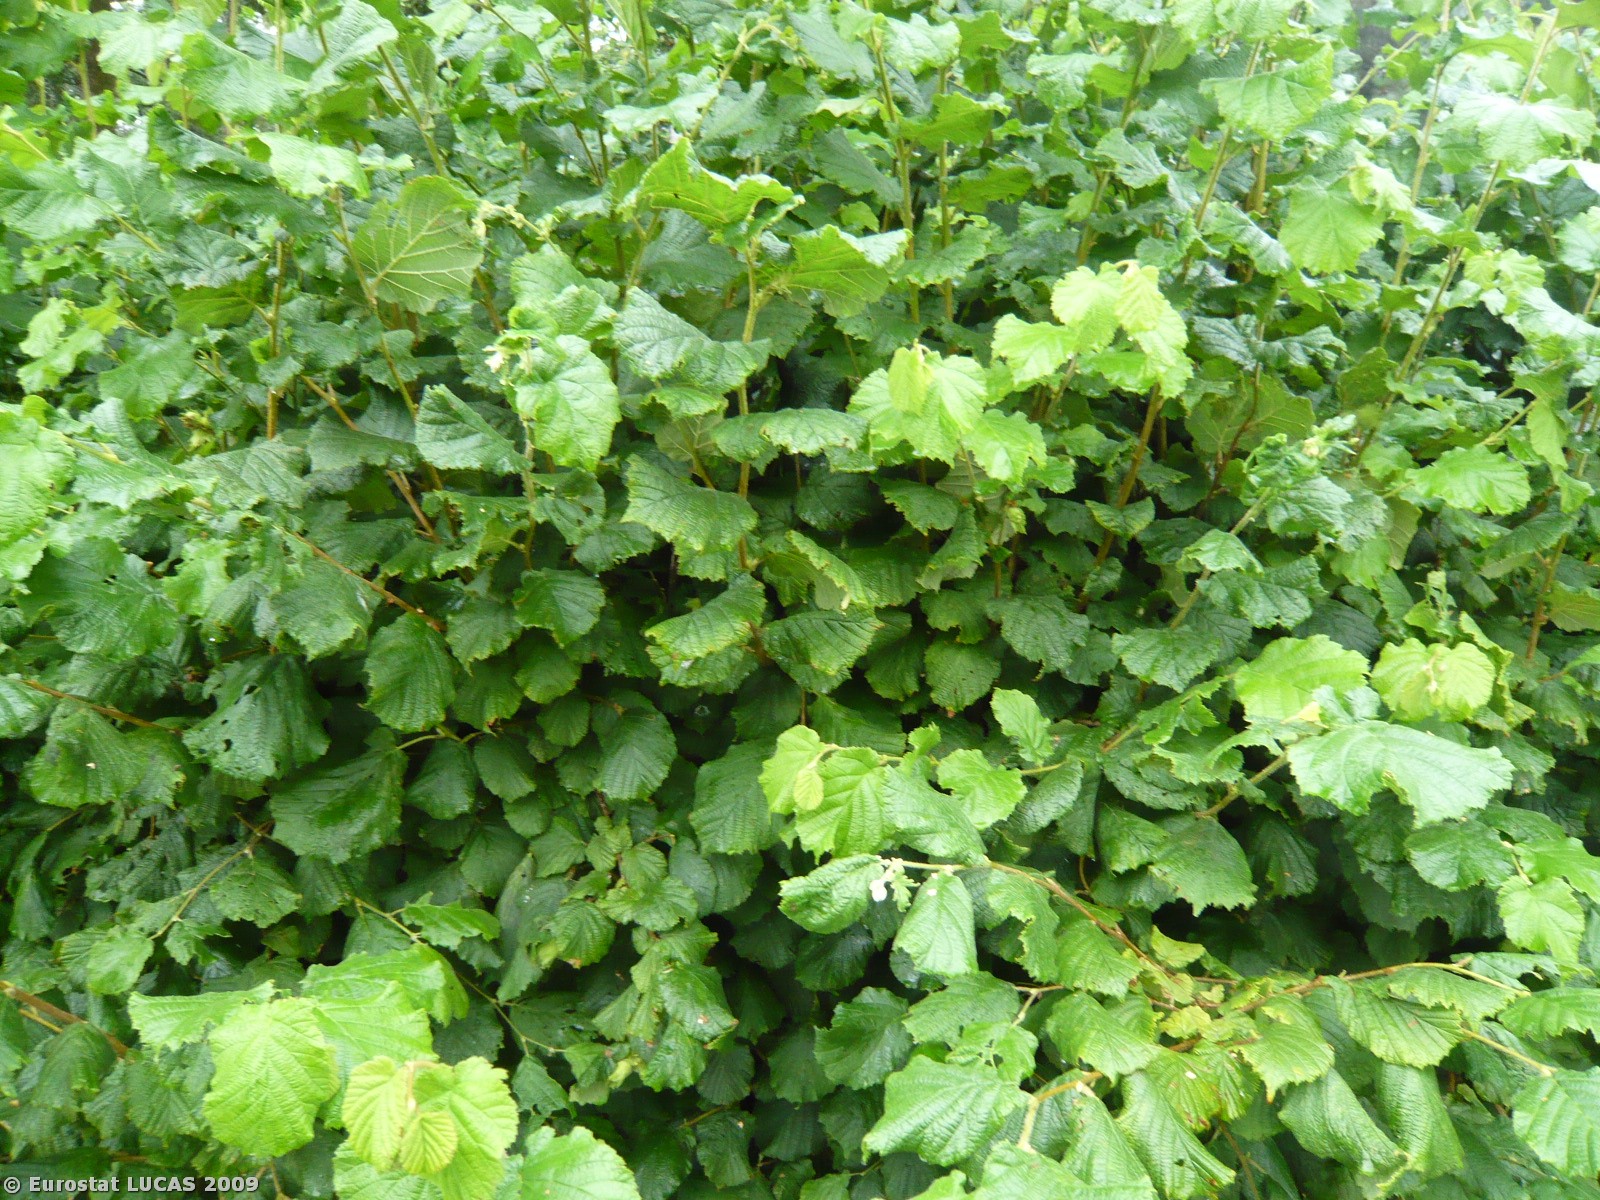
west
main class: Cropland
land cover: Rape and turnip rape
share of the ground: > 75 %
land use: Agriculture (excluding fallow land and kitchen gardens)
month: July
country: DK
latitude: 55.7787
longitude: 11.8637
